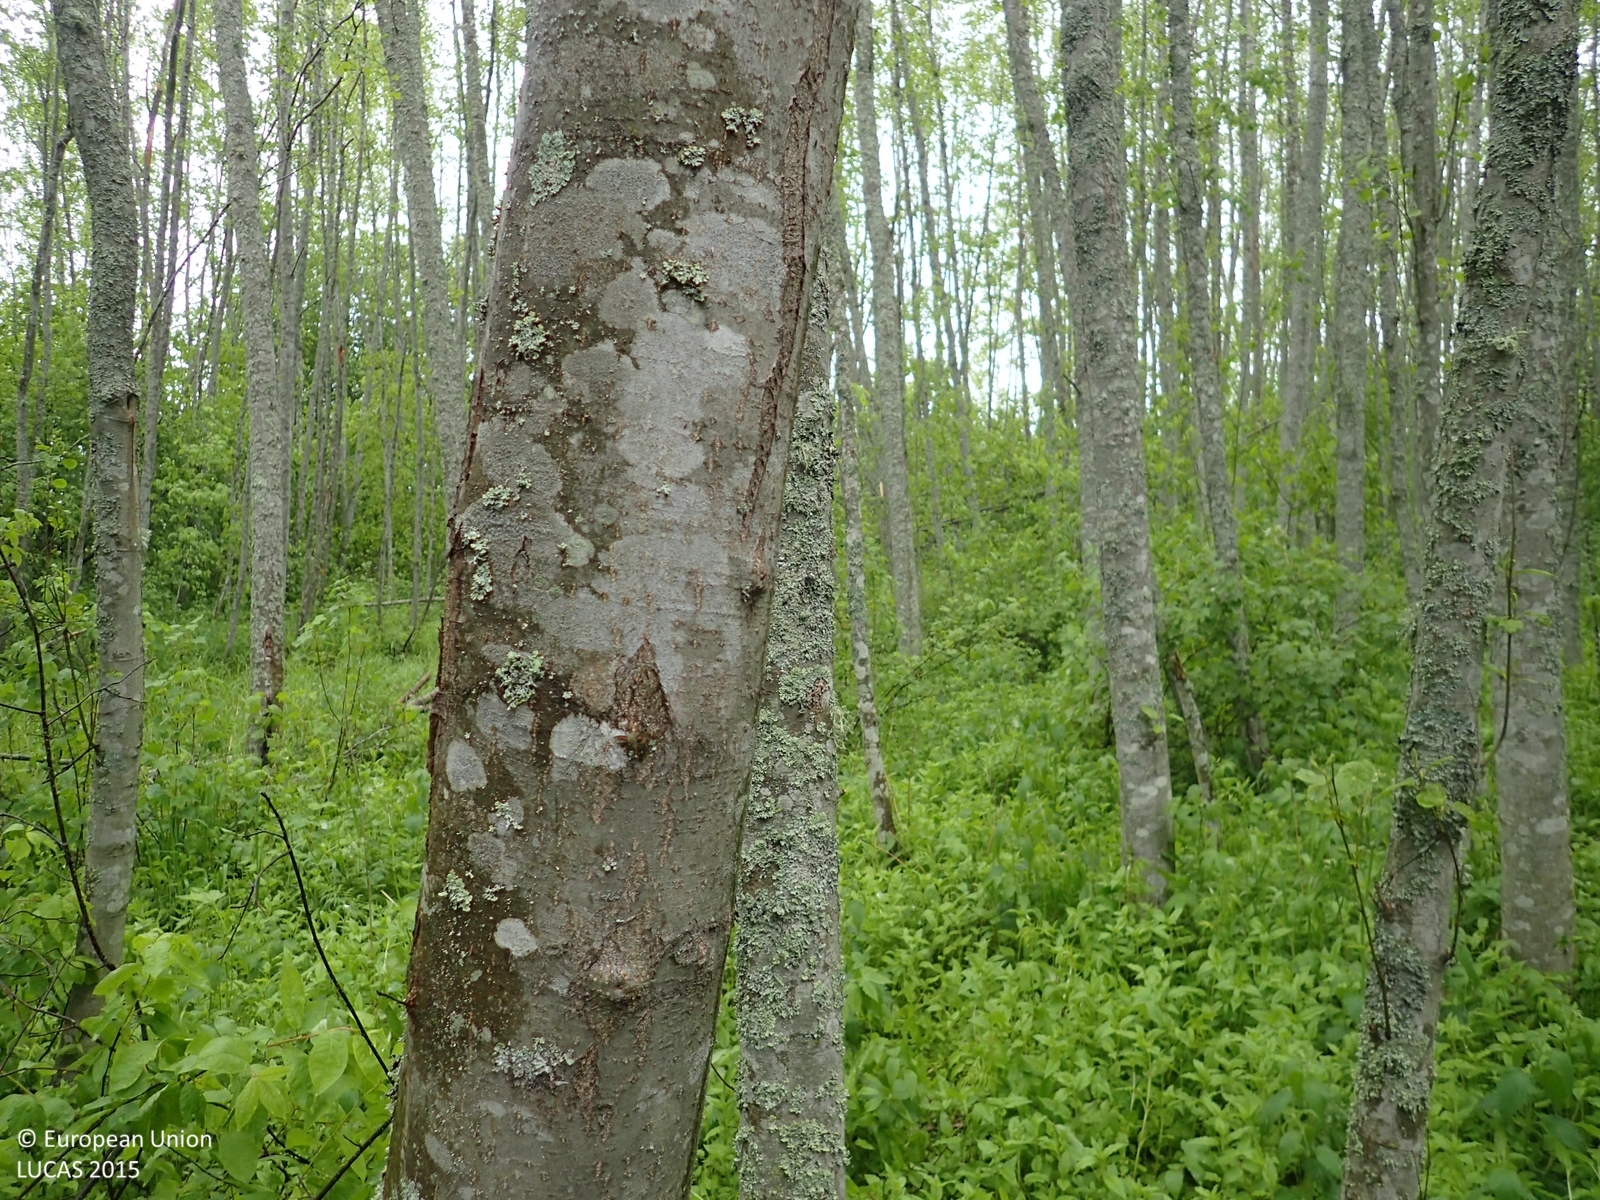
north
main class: Woodland
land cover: Broadleaved woodland
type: non-riverine alder, birch or aspen forest
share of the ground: > 75 %
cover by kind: broadleaved forest trees 90 %, shrubs 10 %
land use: Semi-natural and natural areas not in use
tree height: > 5 m
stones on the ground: < 10 %
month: June
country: FI
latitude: 62.2347
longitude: 21.6109
